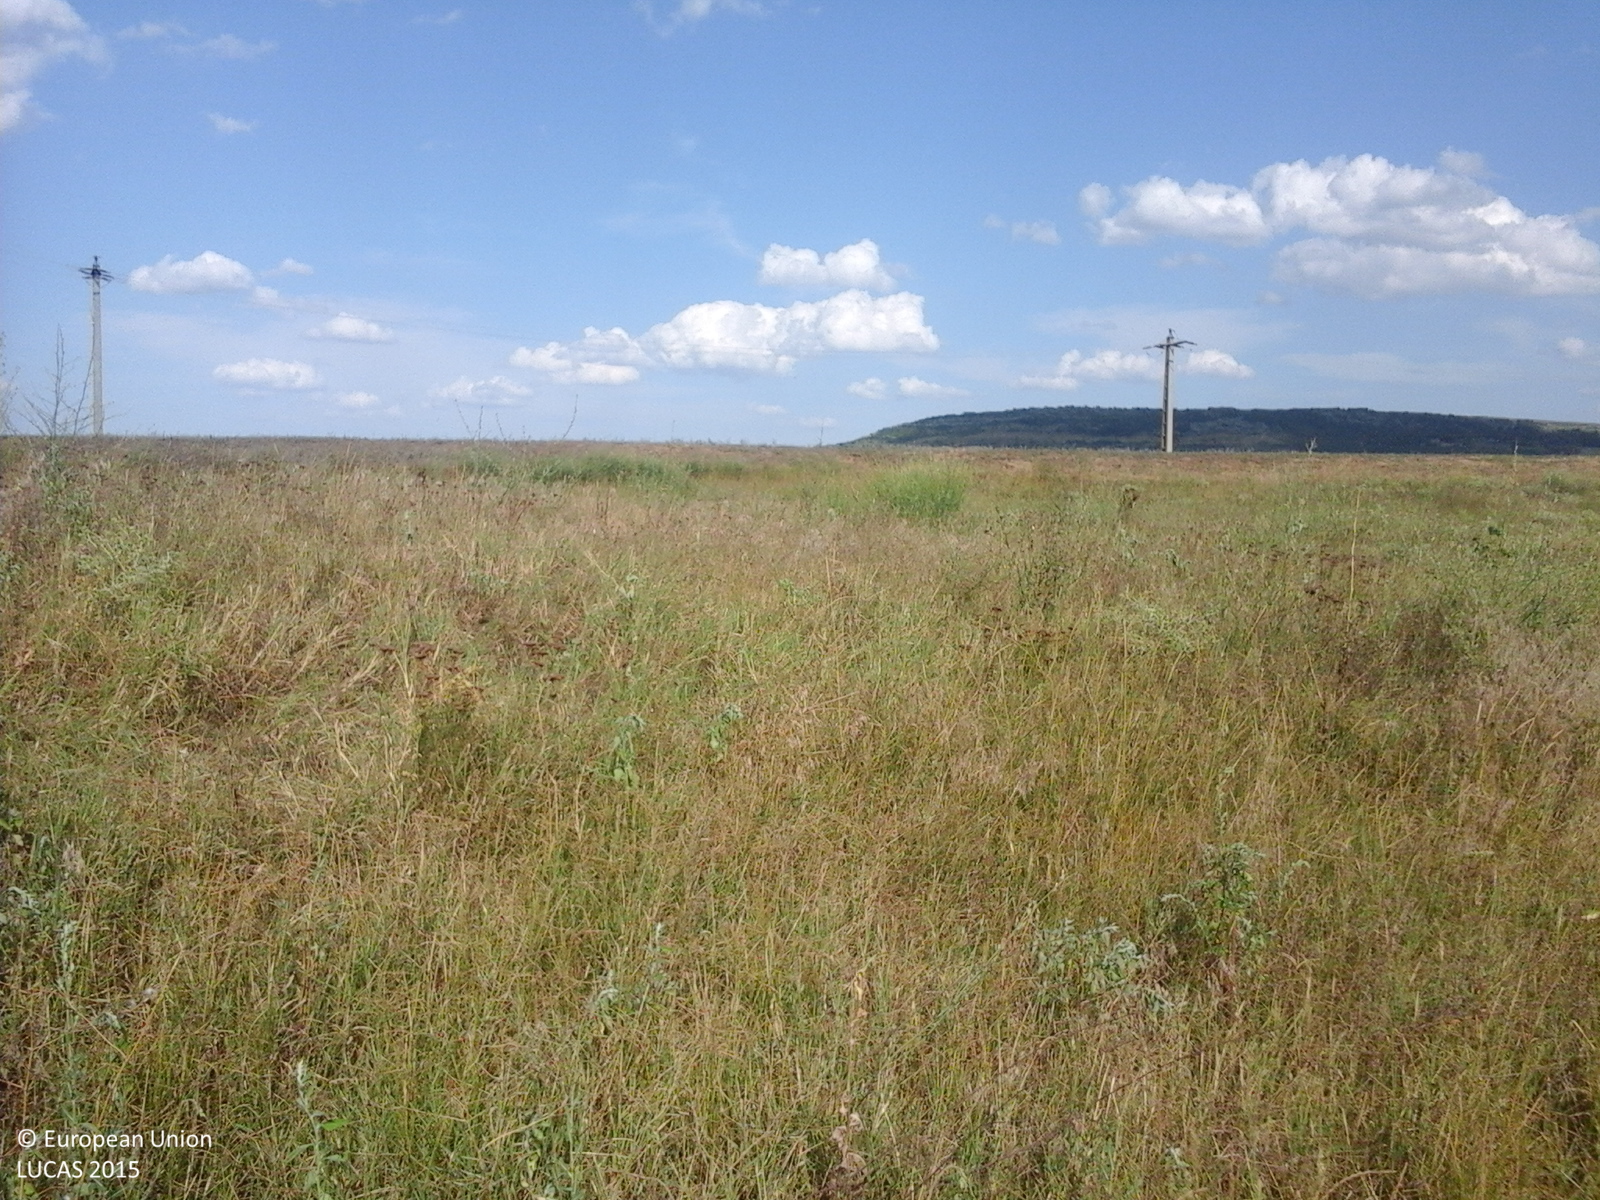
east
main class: Grassland
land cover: Grassland without tree/shrub cover
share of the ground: > 75 %
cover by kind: herbaceous plants 100 %
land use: Agriculture (excluding fallow land and kitchen gardens)
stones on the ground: < 10 %
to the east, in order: Grassland without tree/shrub cover; Tracks; Grassland without tree/shrub cover; Electric lines; Grassland without tree/shrub cover; Common wheat; Grassland without tree/shrub cover
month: July
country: RO
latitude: 46.3396
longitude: 27.7742
